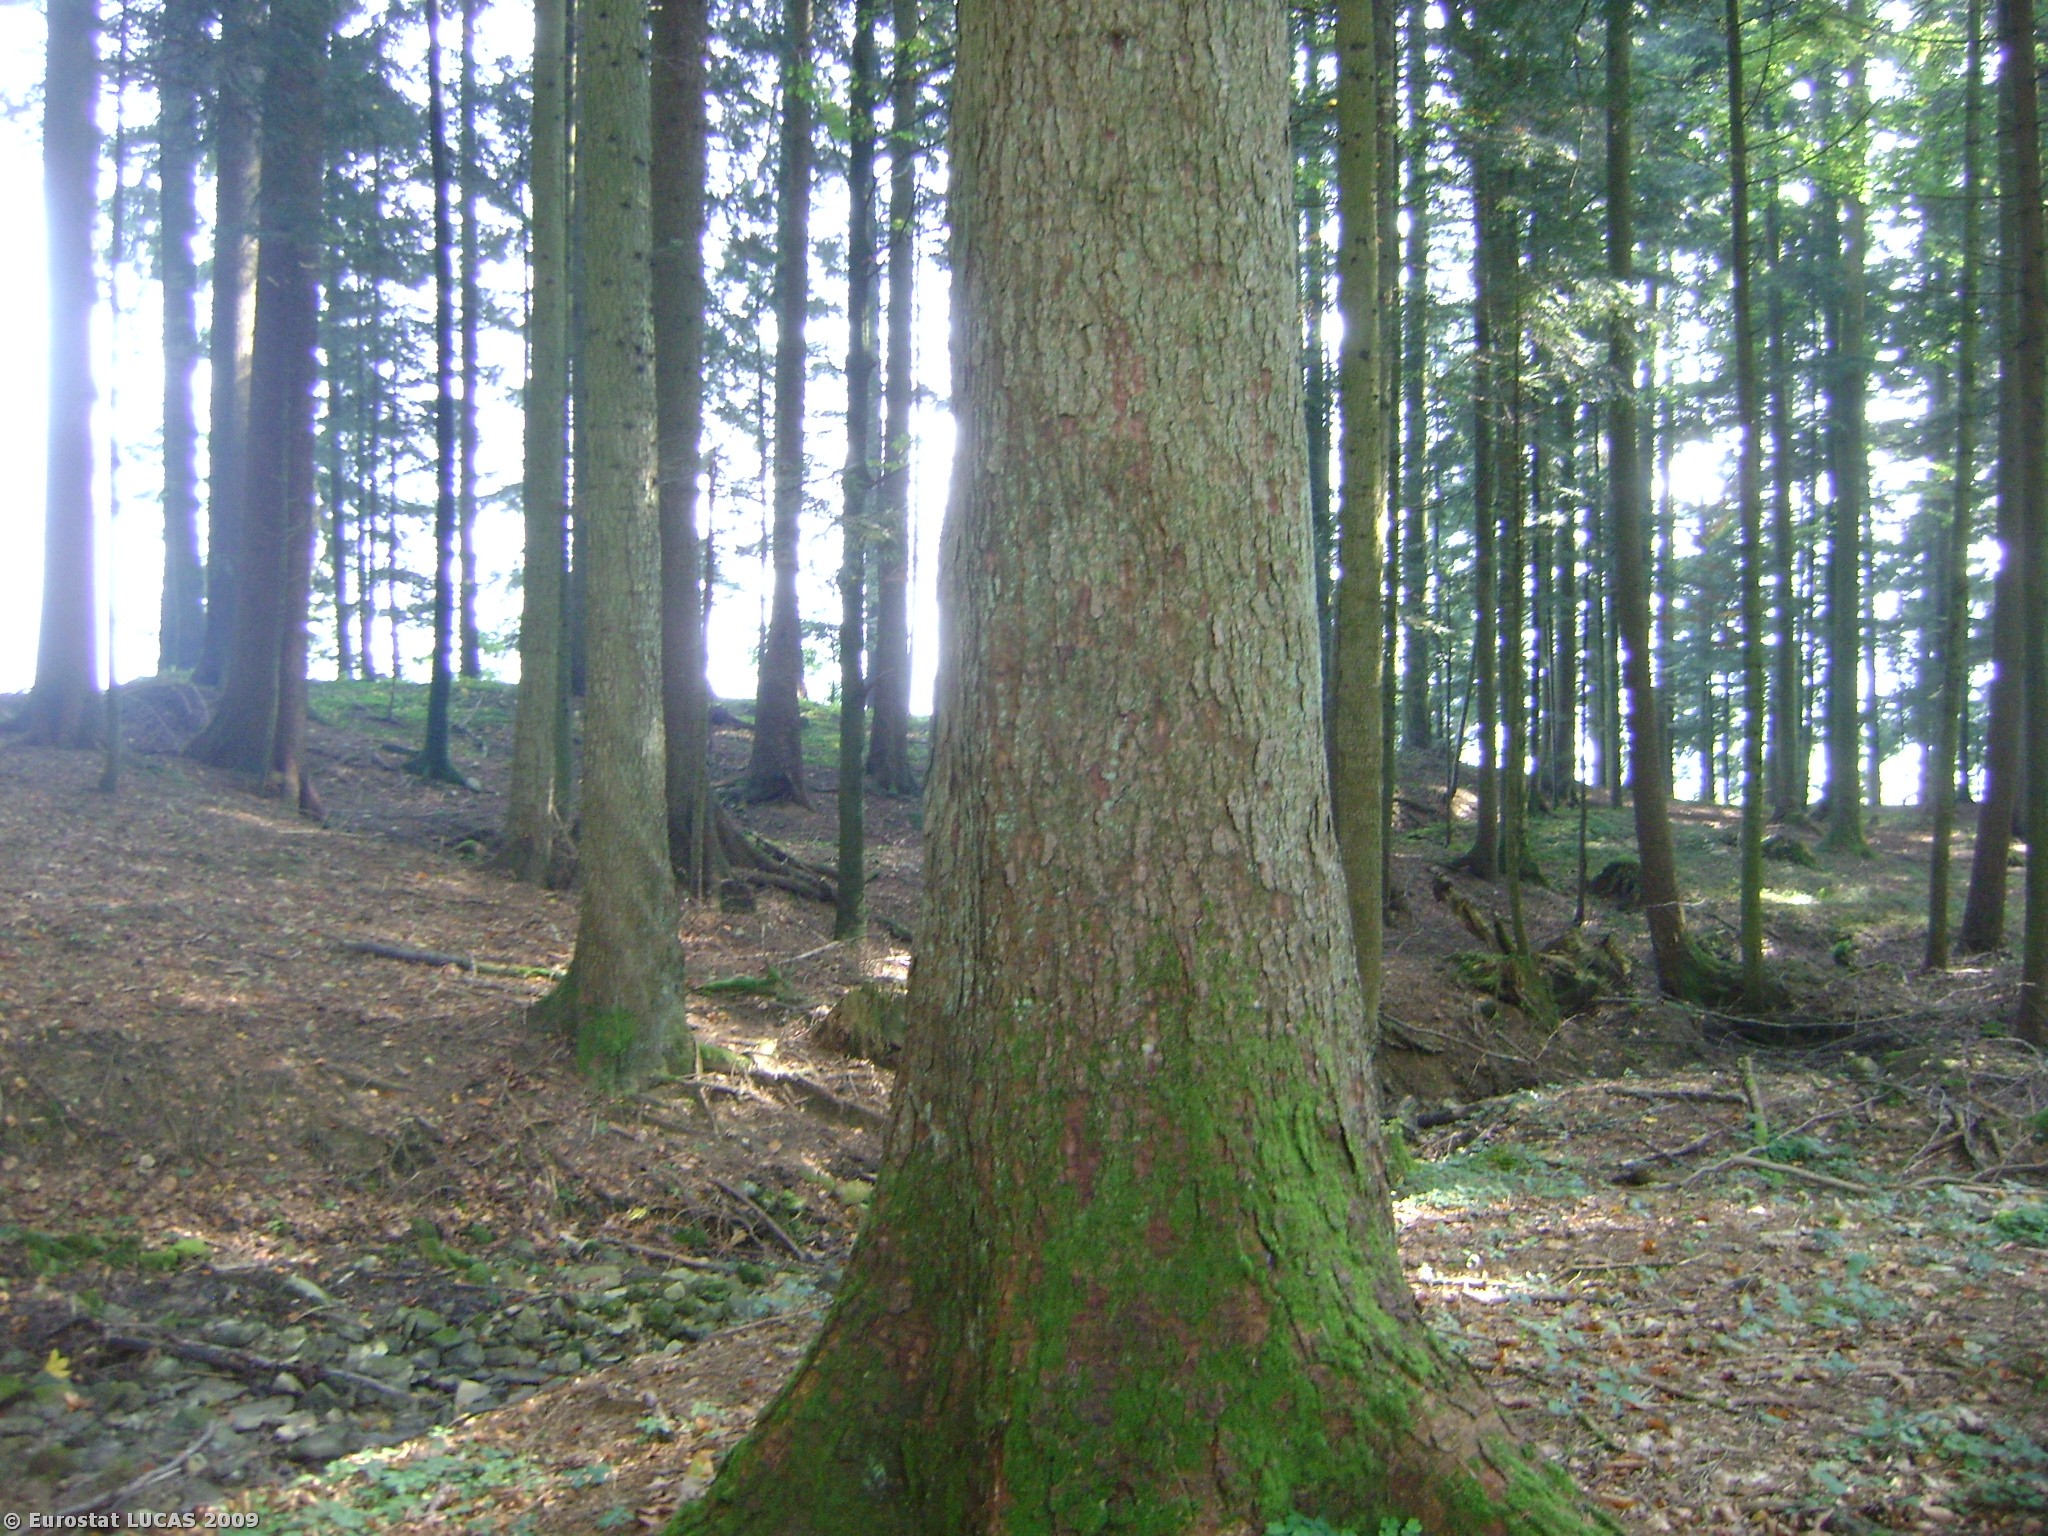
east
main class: Woodland
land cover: Mixed woodland
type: hemiboreal forest and nemoral coniferous forest and mixed broadleaved-coniferous forest
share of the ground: > 75 %
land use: Forestry
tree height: > 5 m
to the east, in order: Mixed woodland; Grassland without tree/shrub cover; Tracks; Grassland with sparse tree/shrub cover; Grassland without tree/shrub cover
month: September
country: AT
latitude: 47.8680
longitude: 13.3008
